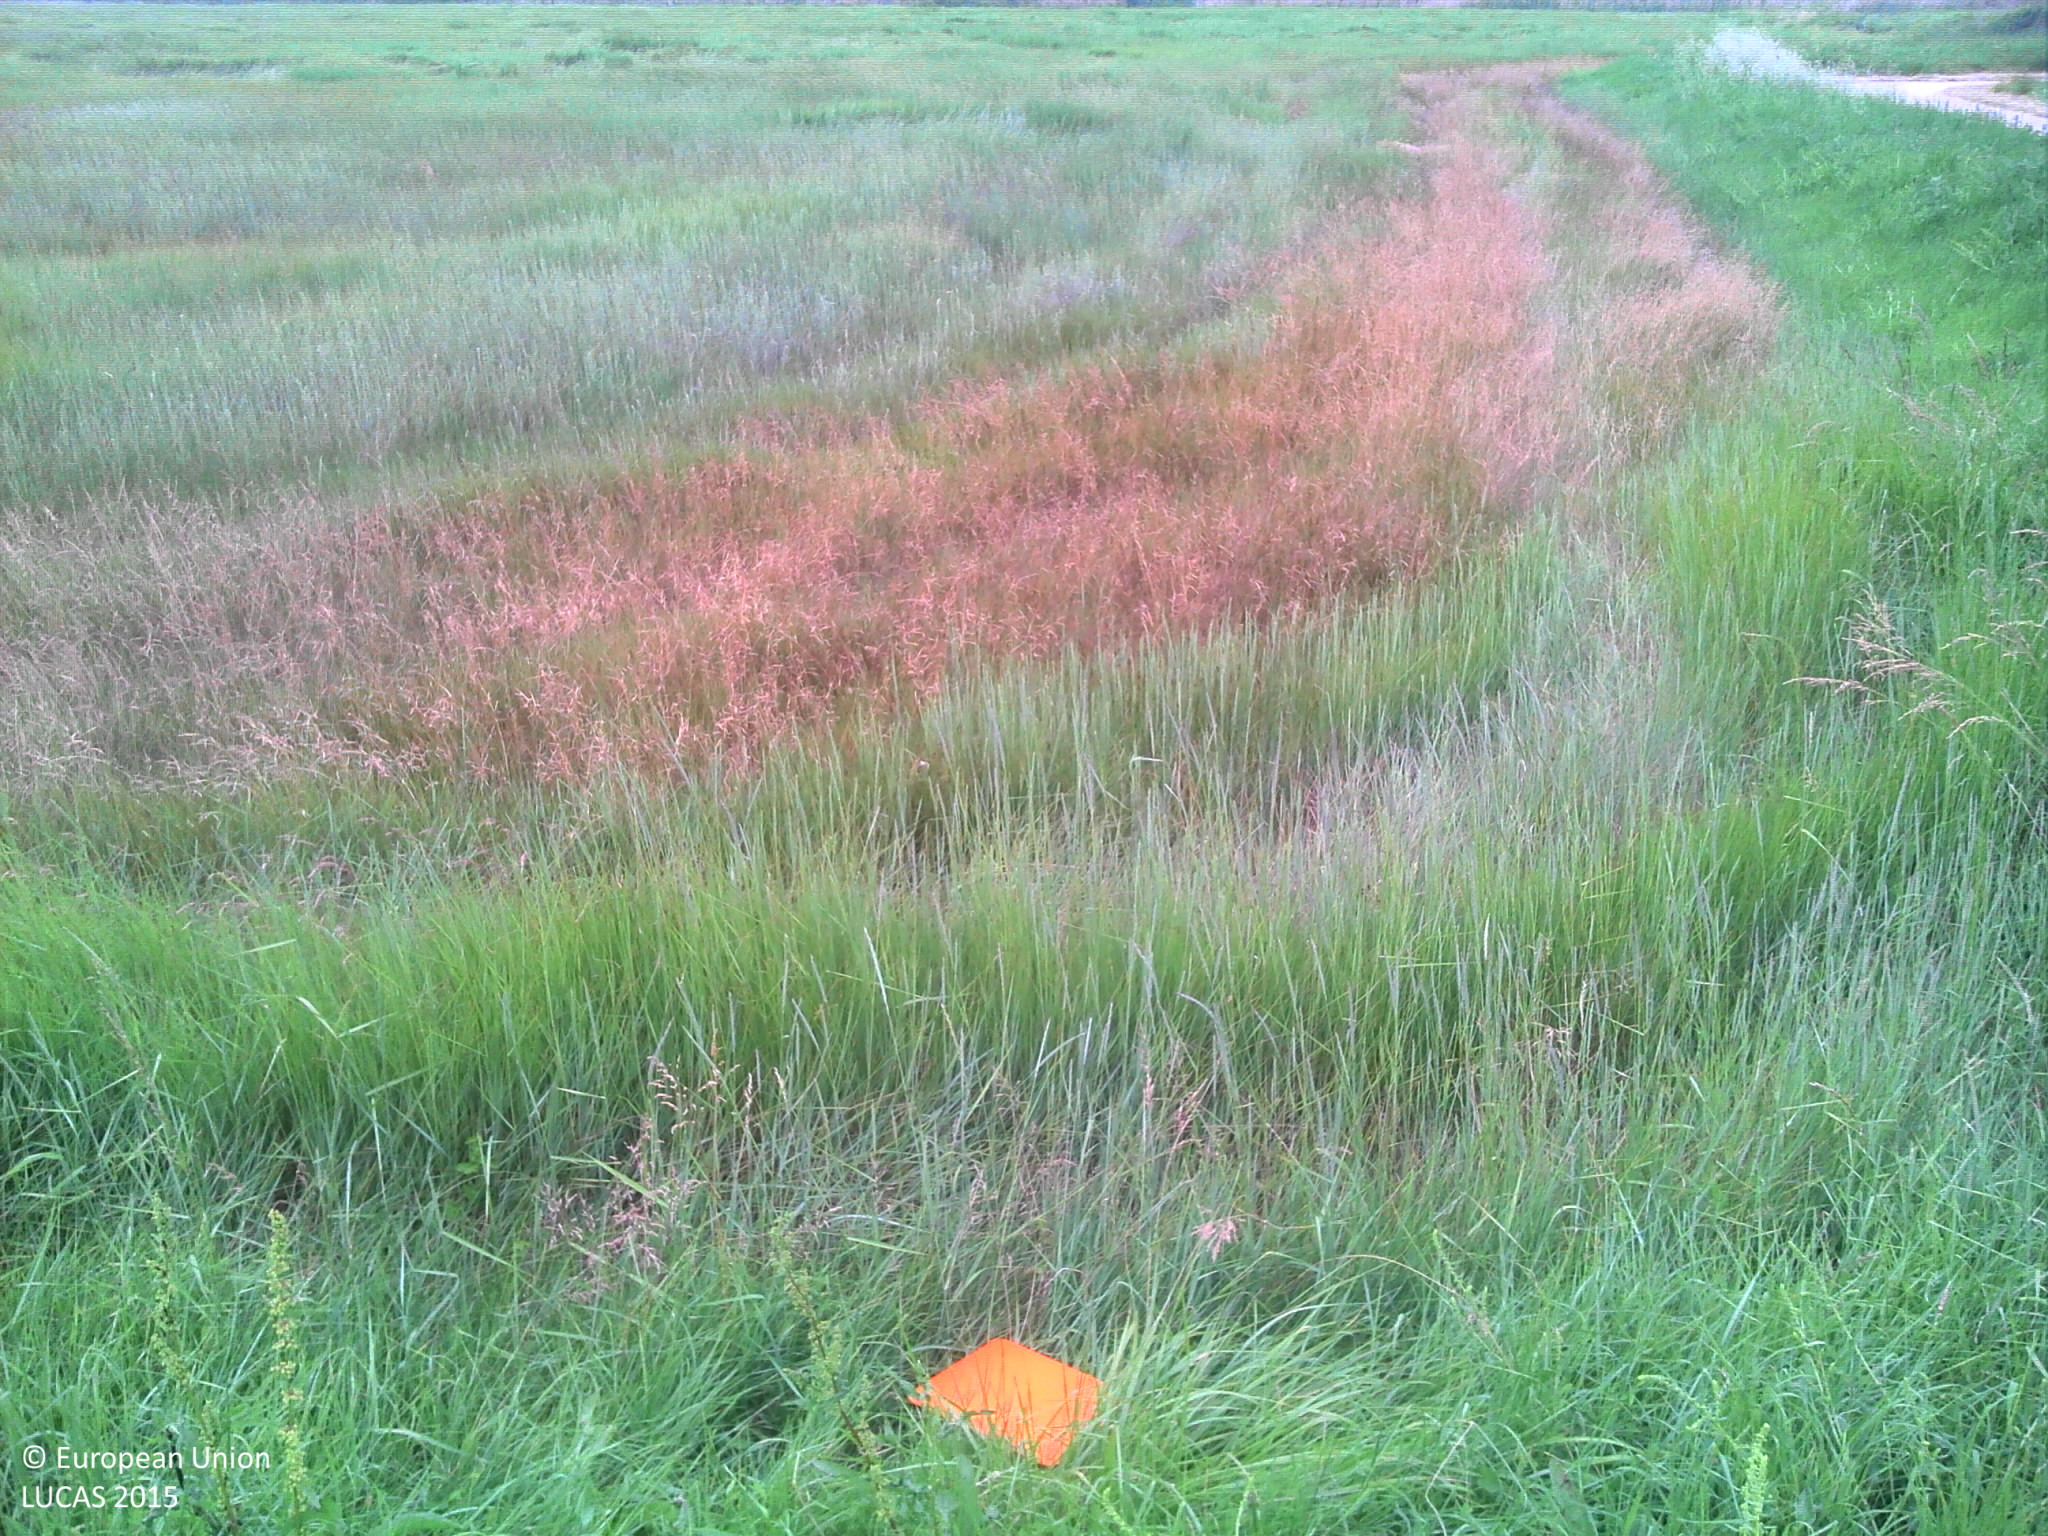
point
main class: Grassland
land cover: Grassland without tree/shrub cover
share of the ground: > 75 %
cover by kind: herbaceous plants 95 %, shrubs 5 %
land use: Agriculture (excluding fallow land and kitchen gardens)
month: June
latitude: 45.9271
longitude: -1.0031
